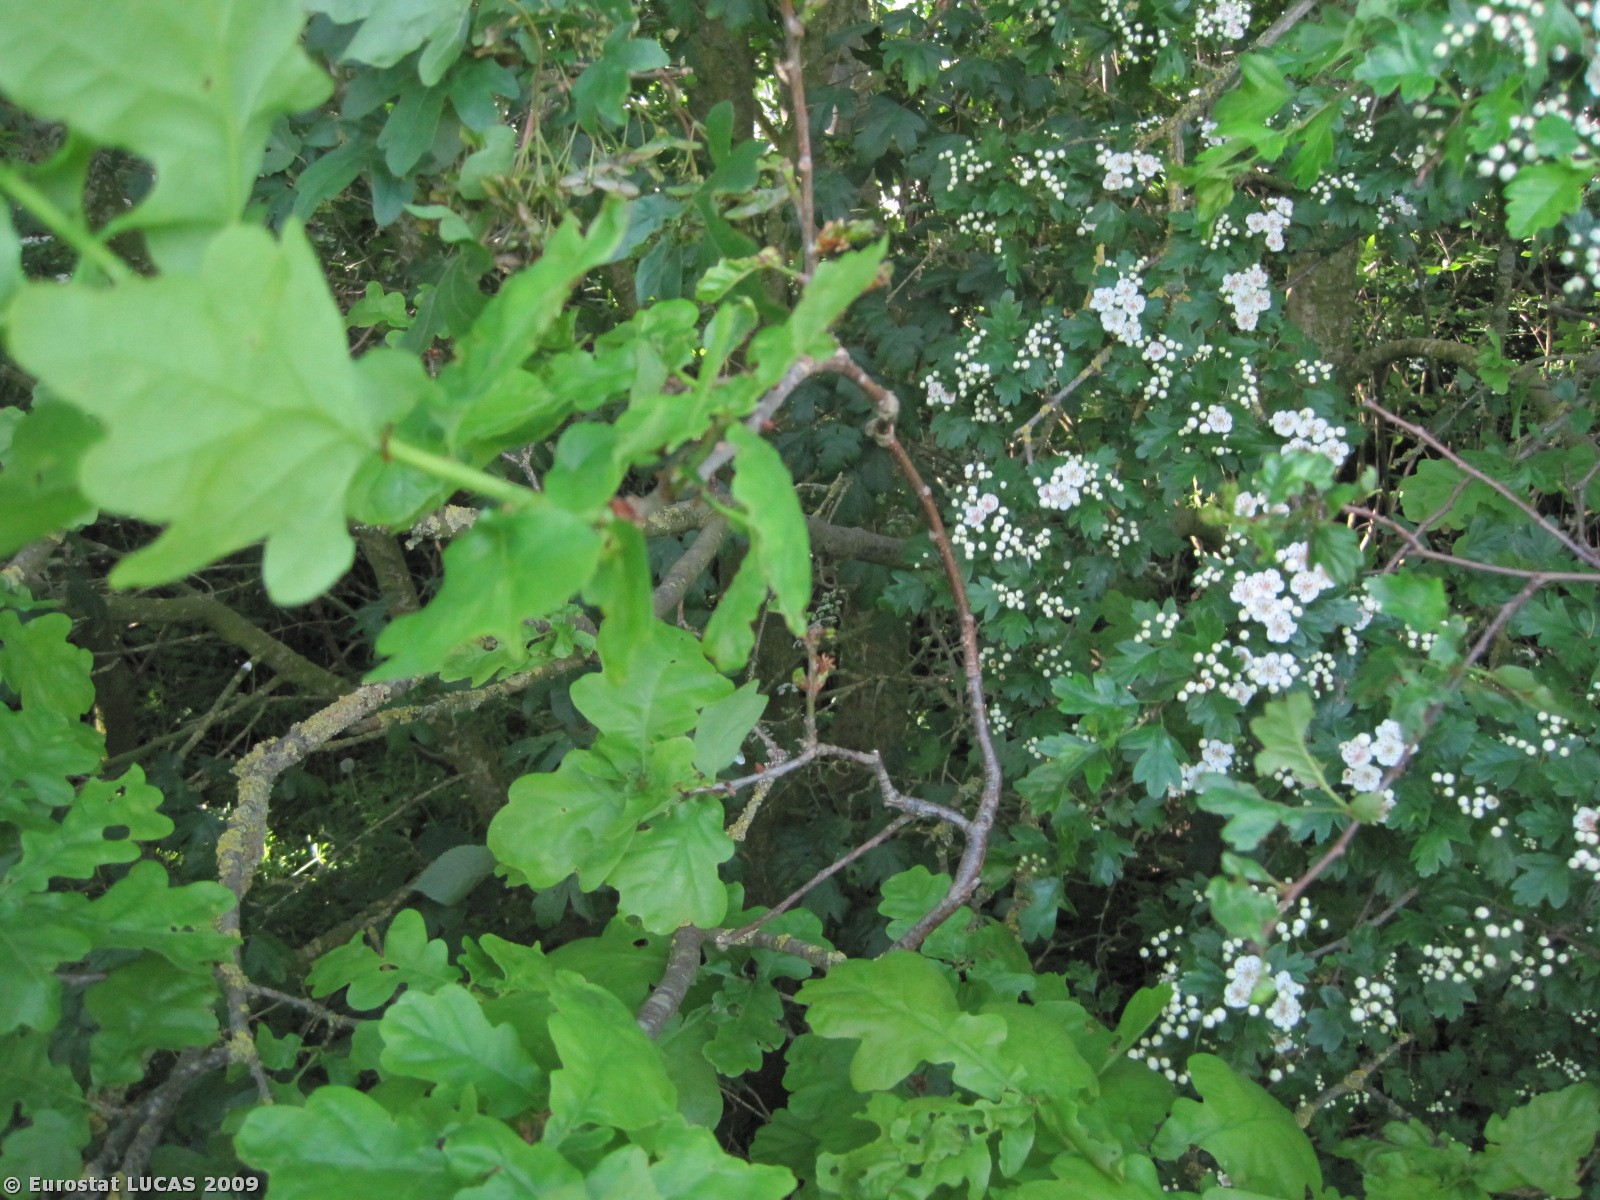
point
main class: Woodland
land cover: Broadleaved woodland
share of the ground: > 75 %
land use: Unused
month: May
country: DK
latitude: 56.5832
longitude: 10.0813
